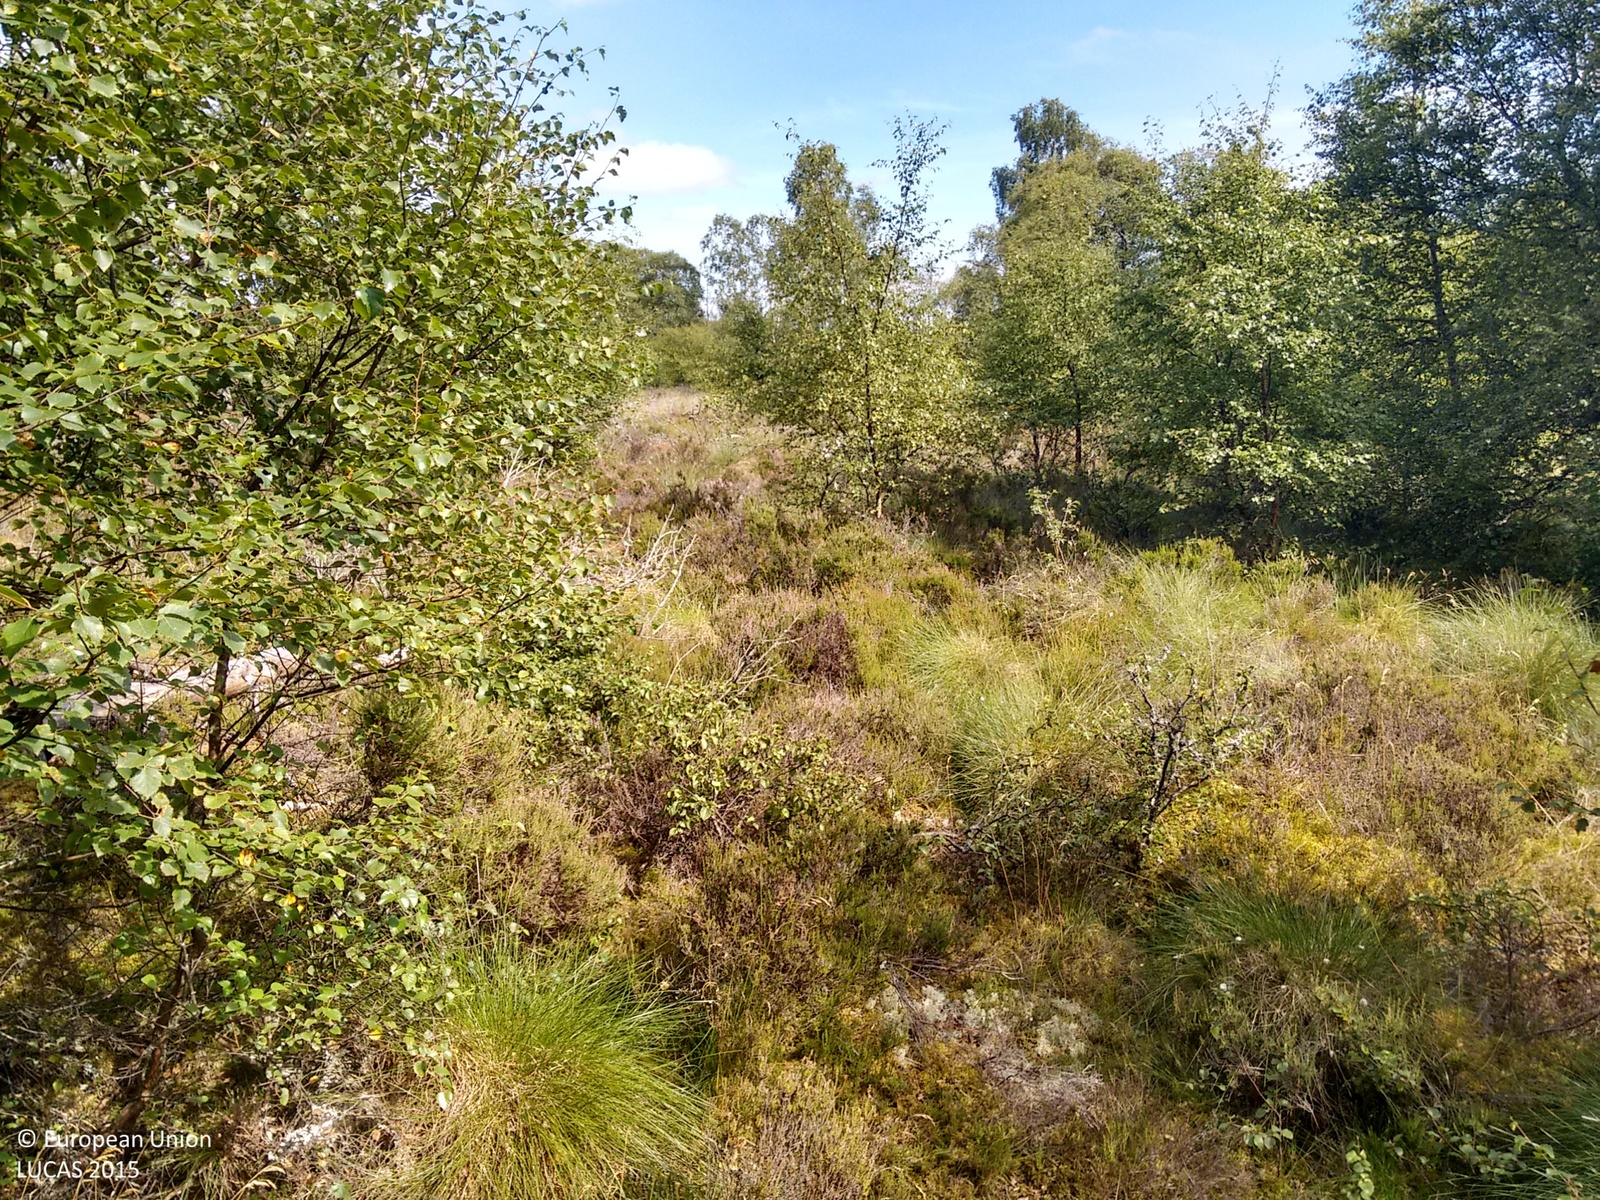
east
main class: Woodland
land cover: Other mixed woodland
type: exotic forest
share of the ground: > 75 %
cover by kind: broadleaved forest trees 55 %, coniferous forest trees 20 %, shrubs 10 %, herbaceous plants 10 %, lichens and mosses 5 %
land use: Forestry
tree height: > 5 m
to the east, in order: Other mixed woodland; Broadleaved woodland; Shrubland without tree cover
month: August
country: GB
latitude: 57.5614
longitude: -3.0495
